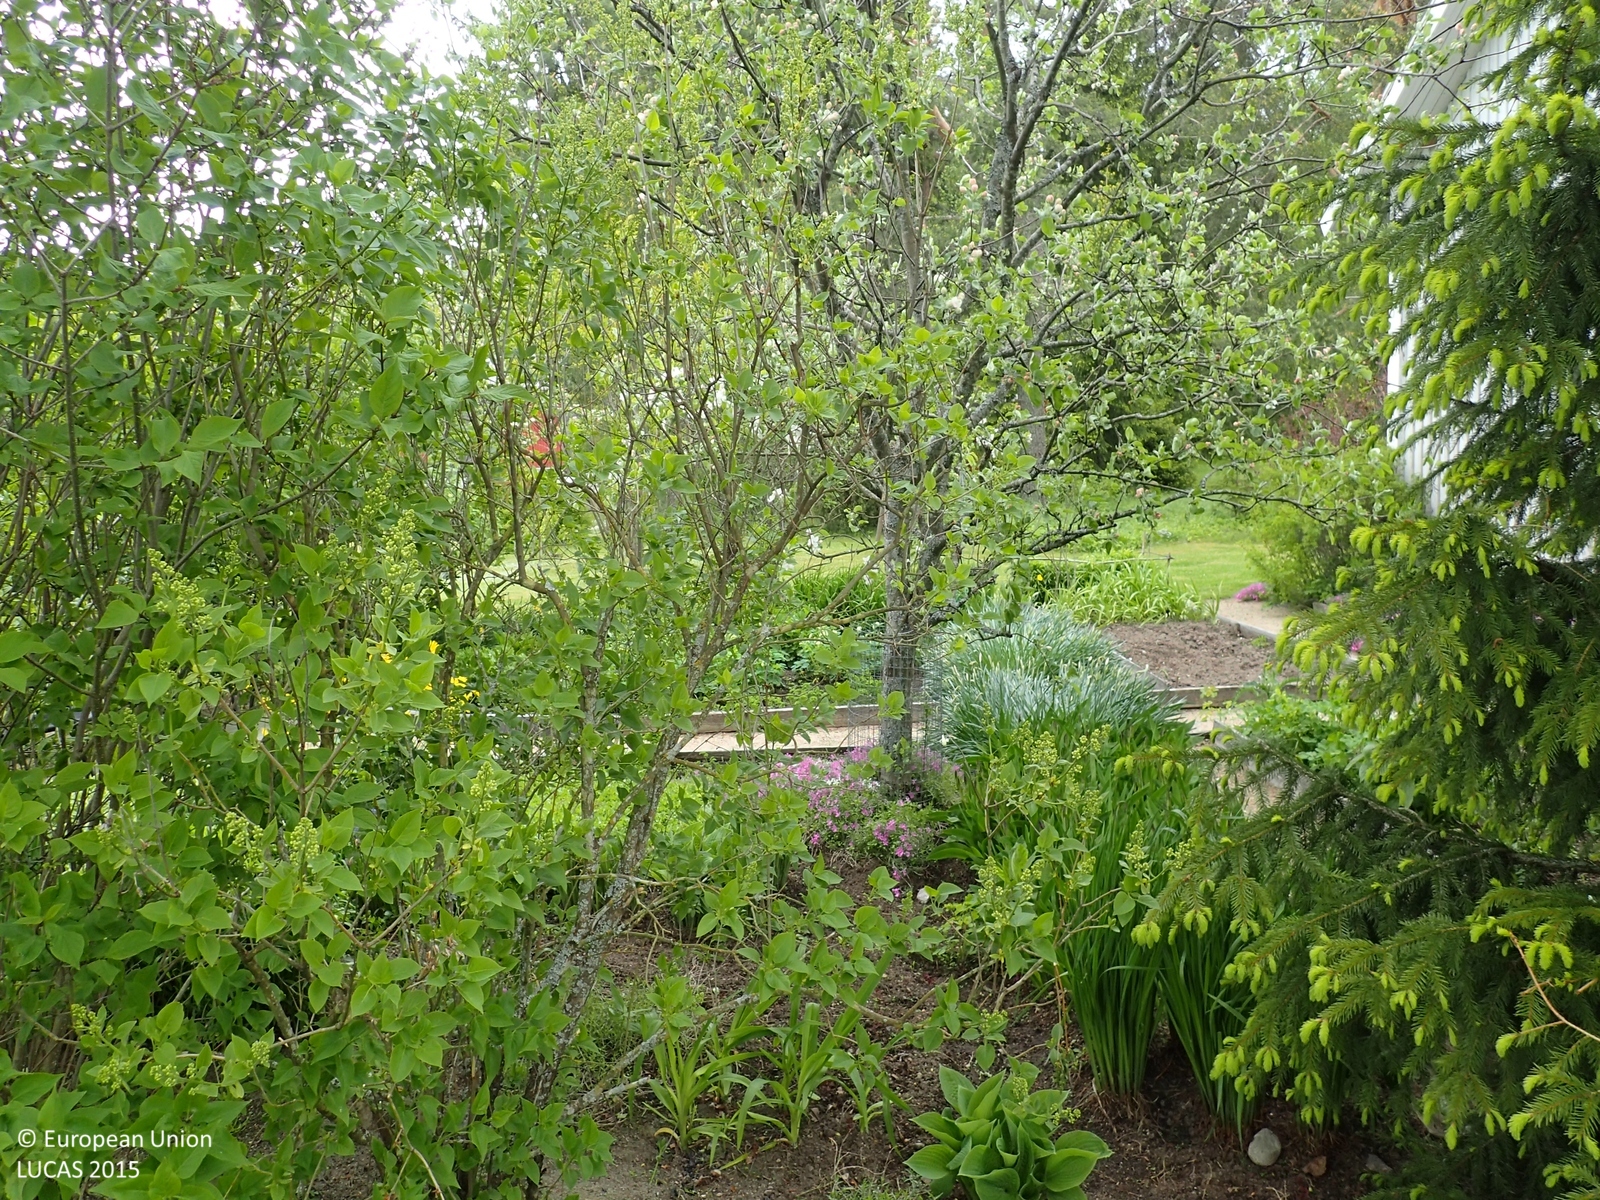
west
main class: Woodland
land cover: Spruce dominated mixed woodland
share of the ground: 10 - 25 %
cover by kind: herbaceous plants 65 %, coniferous forest trees 5 %, broadleaved forest trees 5 %
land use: Residential
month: June
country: FI
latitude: 62.2672
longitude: 21.6623
